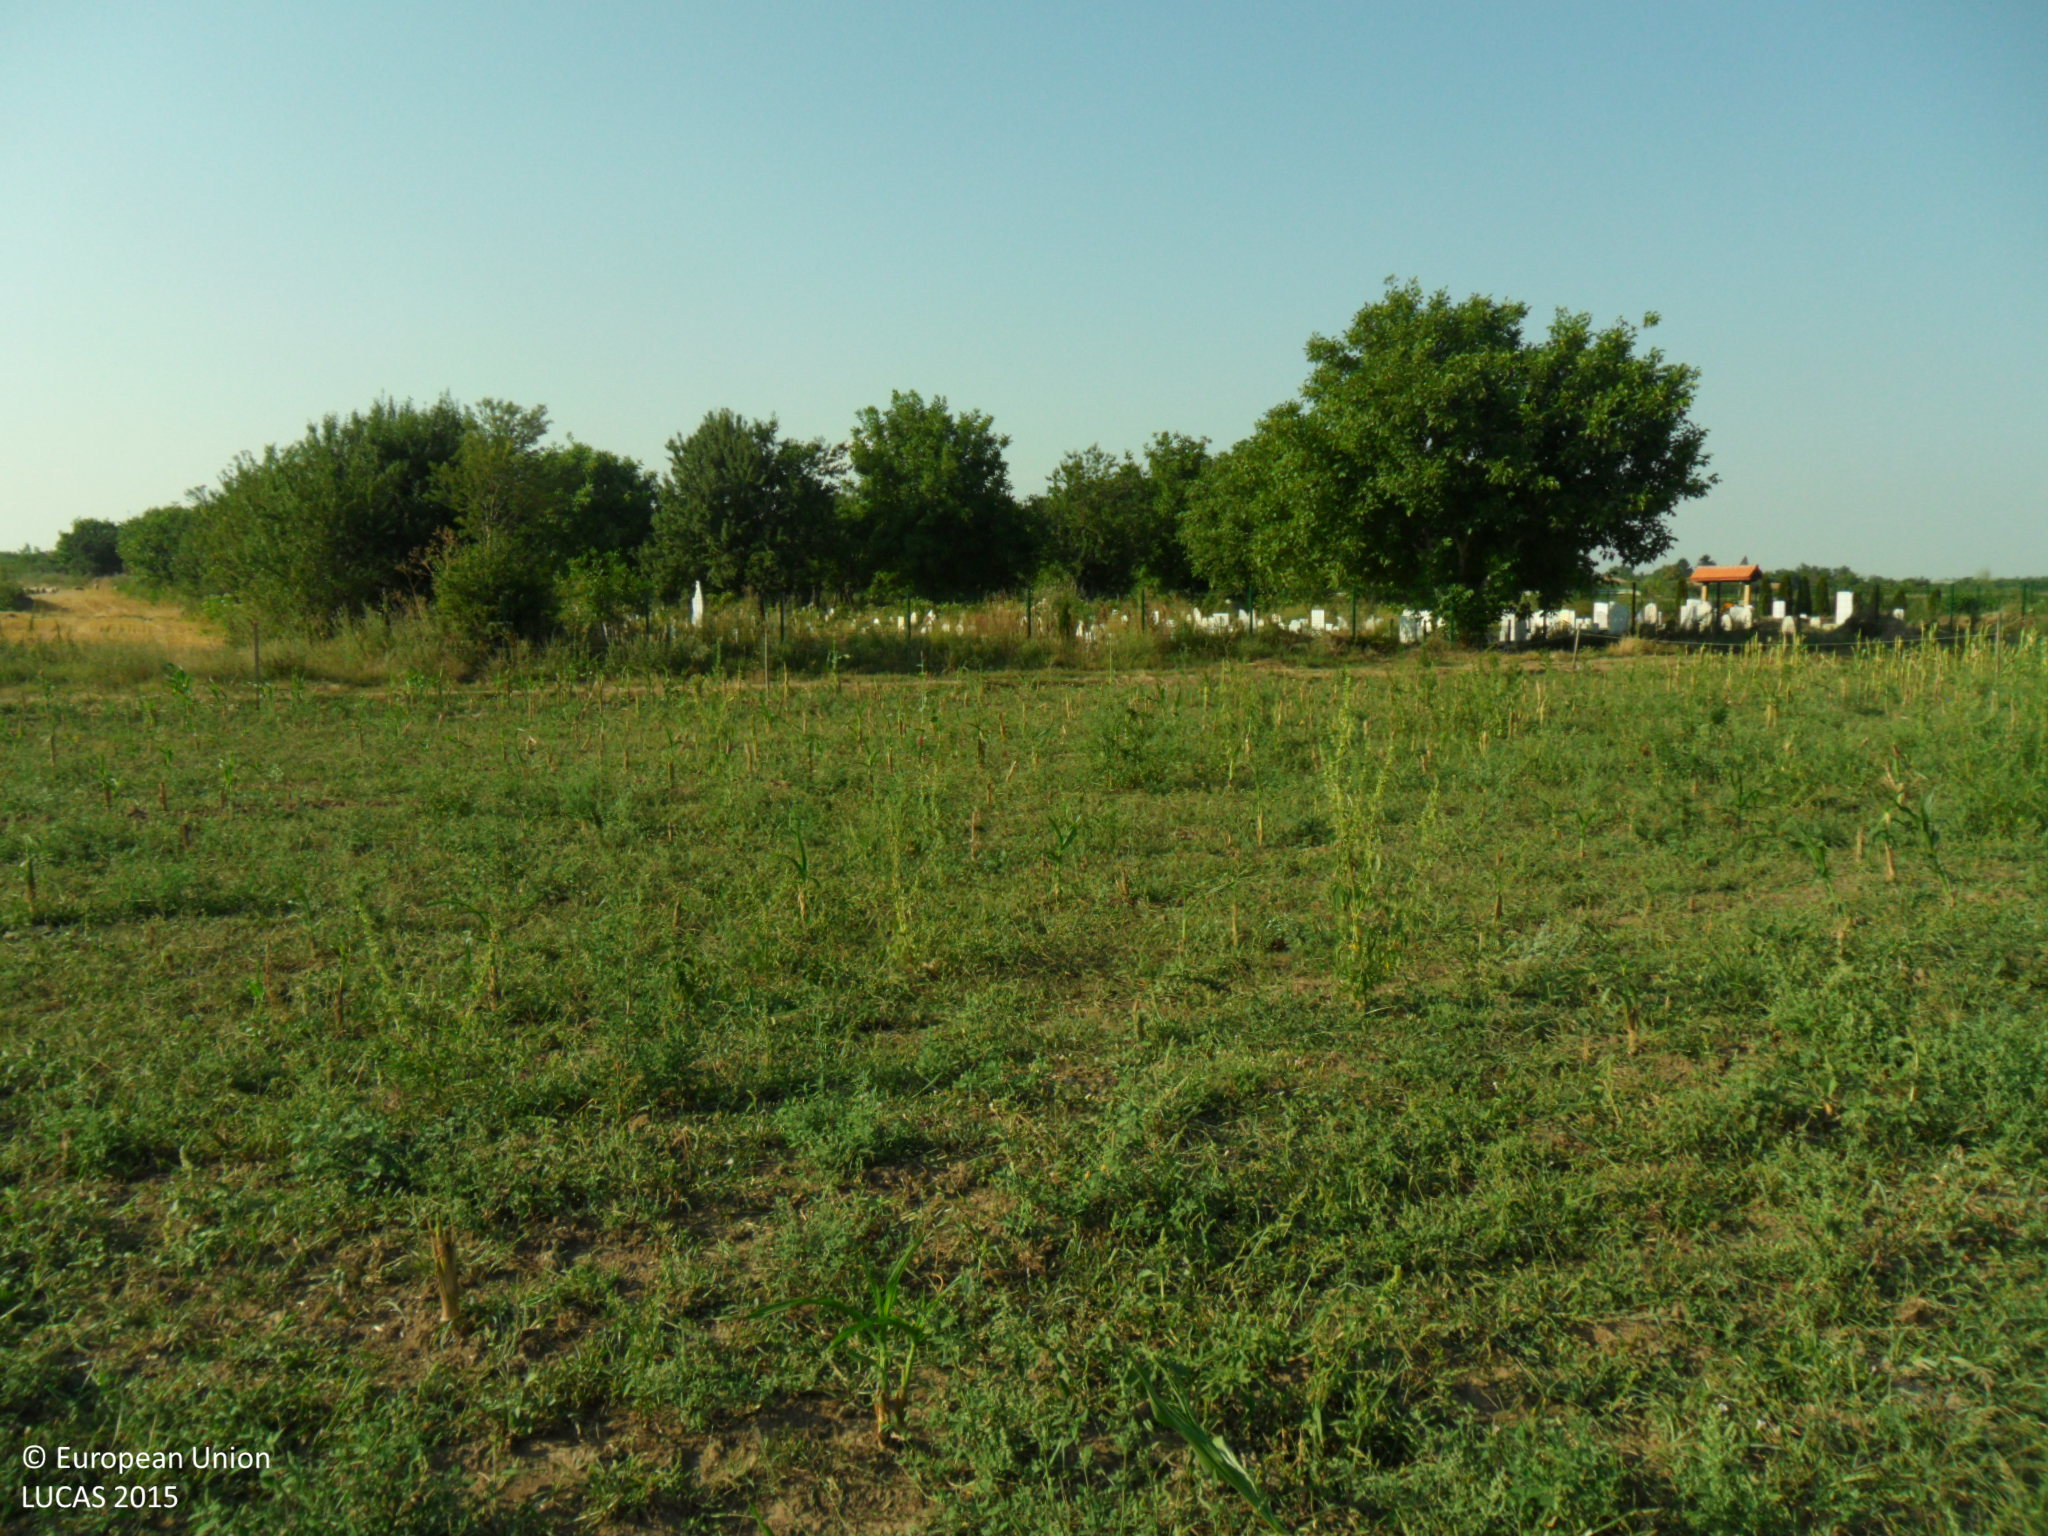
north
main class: Cropland
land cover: Maize
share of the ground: 10 - 25 %
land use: Agriculture (excluding fallow land and kitchen gardens)
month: July
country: BG
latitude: 43.6942
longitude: 27.0828
